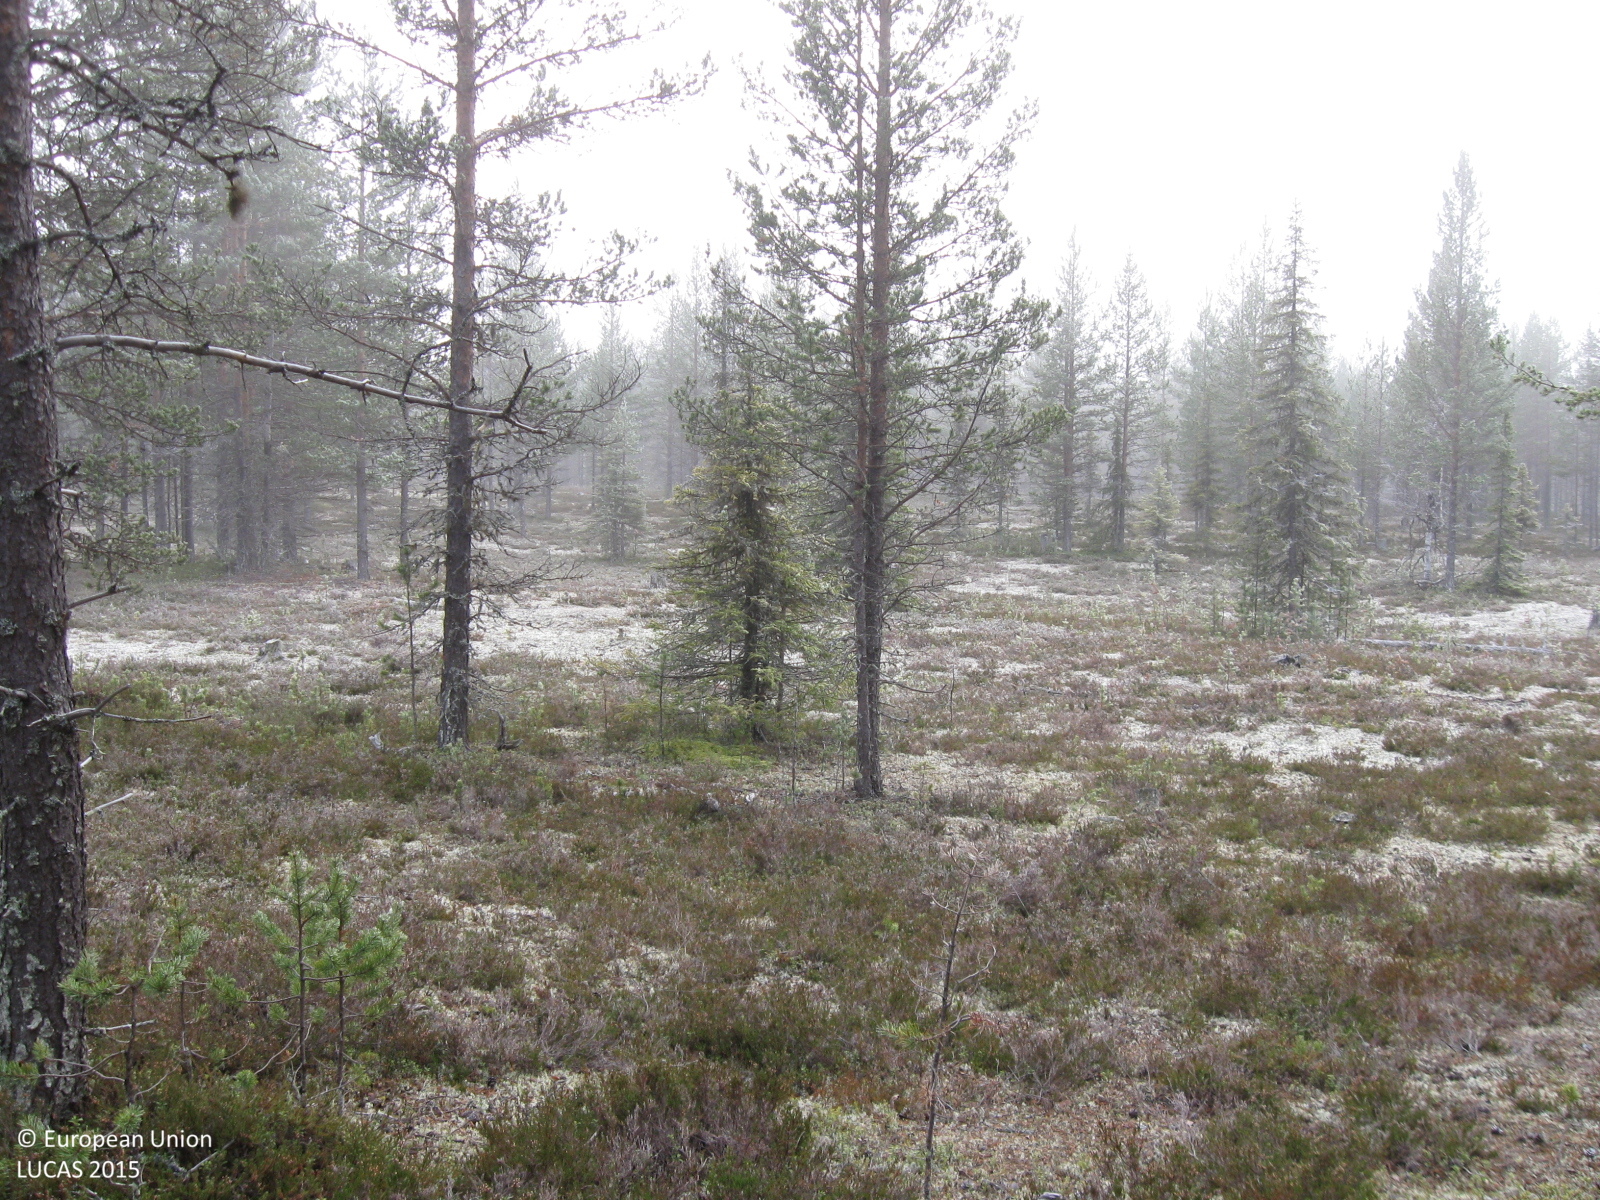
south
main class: Woodland
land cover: Pine dominated coniferous woodland
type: boreal forest
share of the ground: 50 - 75 %
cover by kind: coniferous forest trees 60 %, shrubs 15 %, herbaceous plants 10 %, lichens and mosses 10 %, consolidated bare surface 5 %
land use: Forestry
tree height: > 5 m
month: October
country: SE
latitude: 66.3813
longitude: 21.7087
